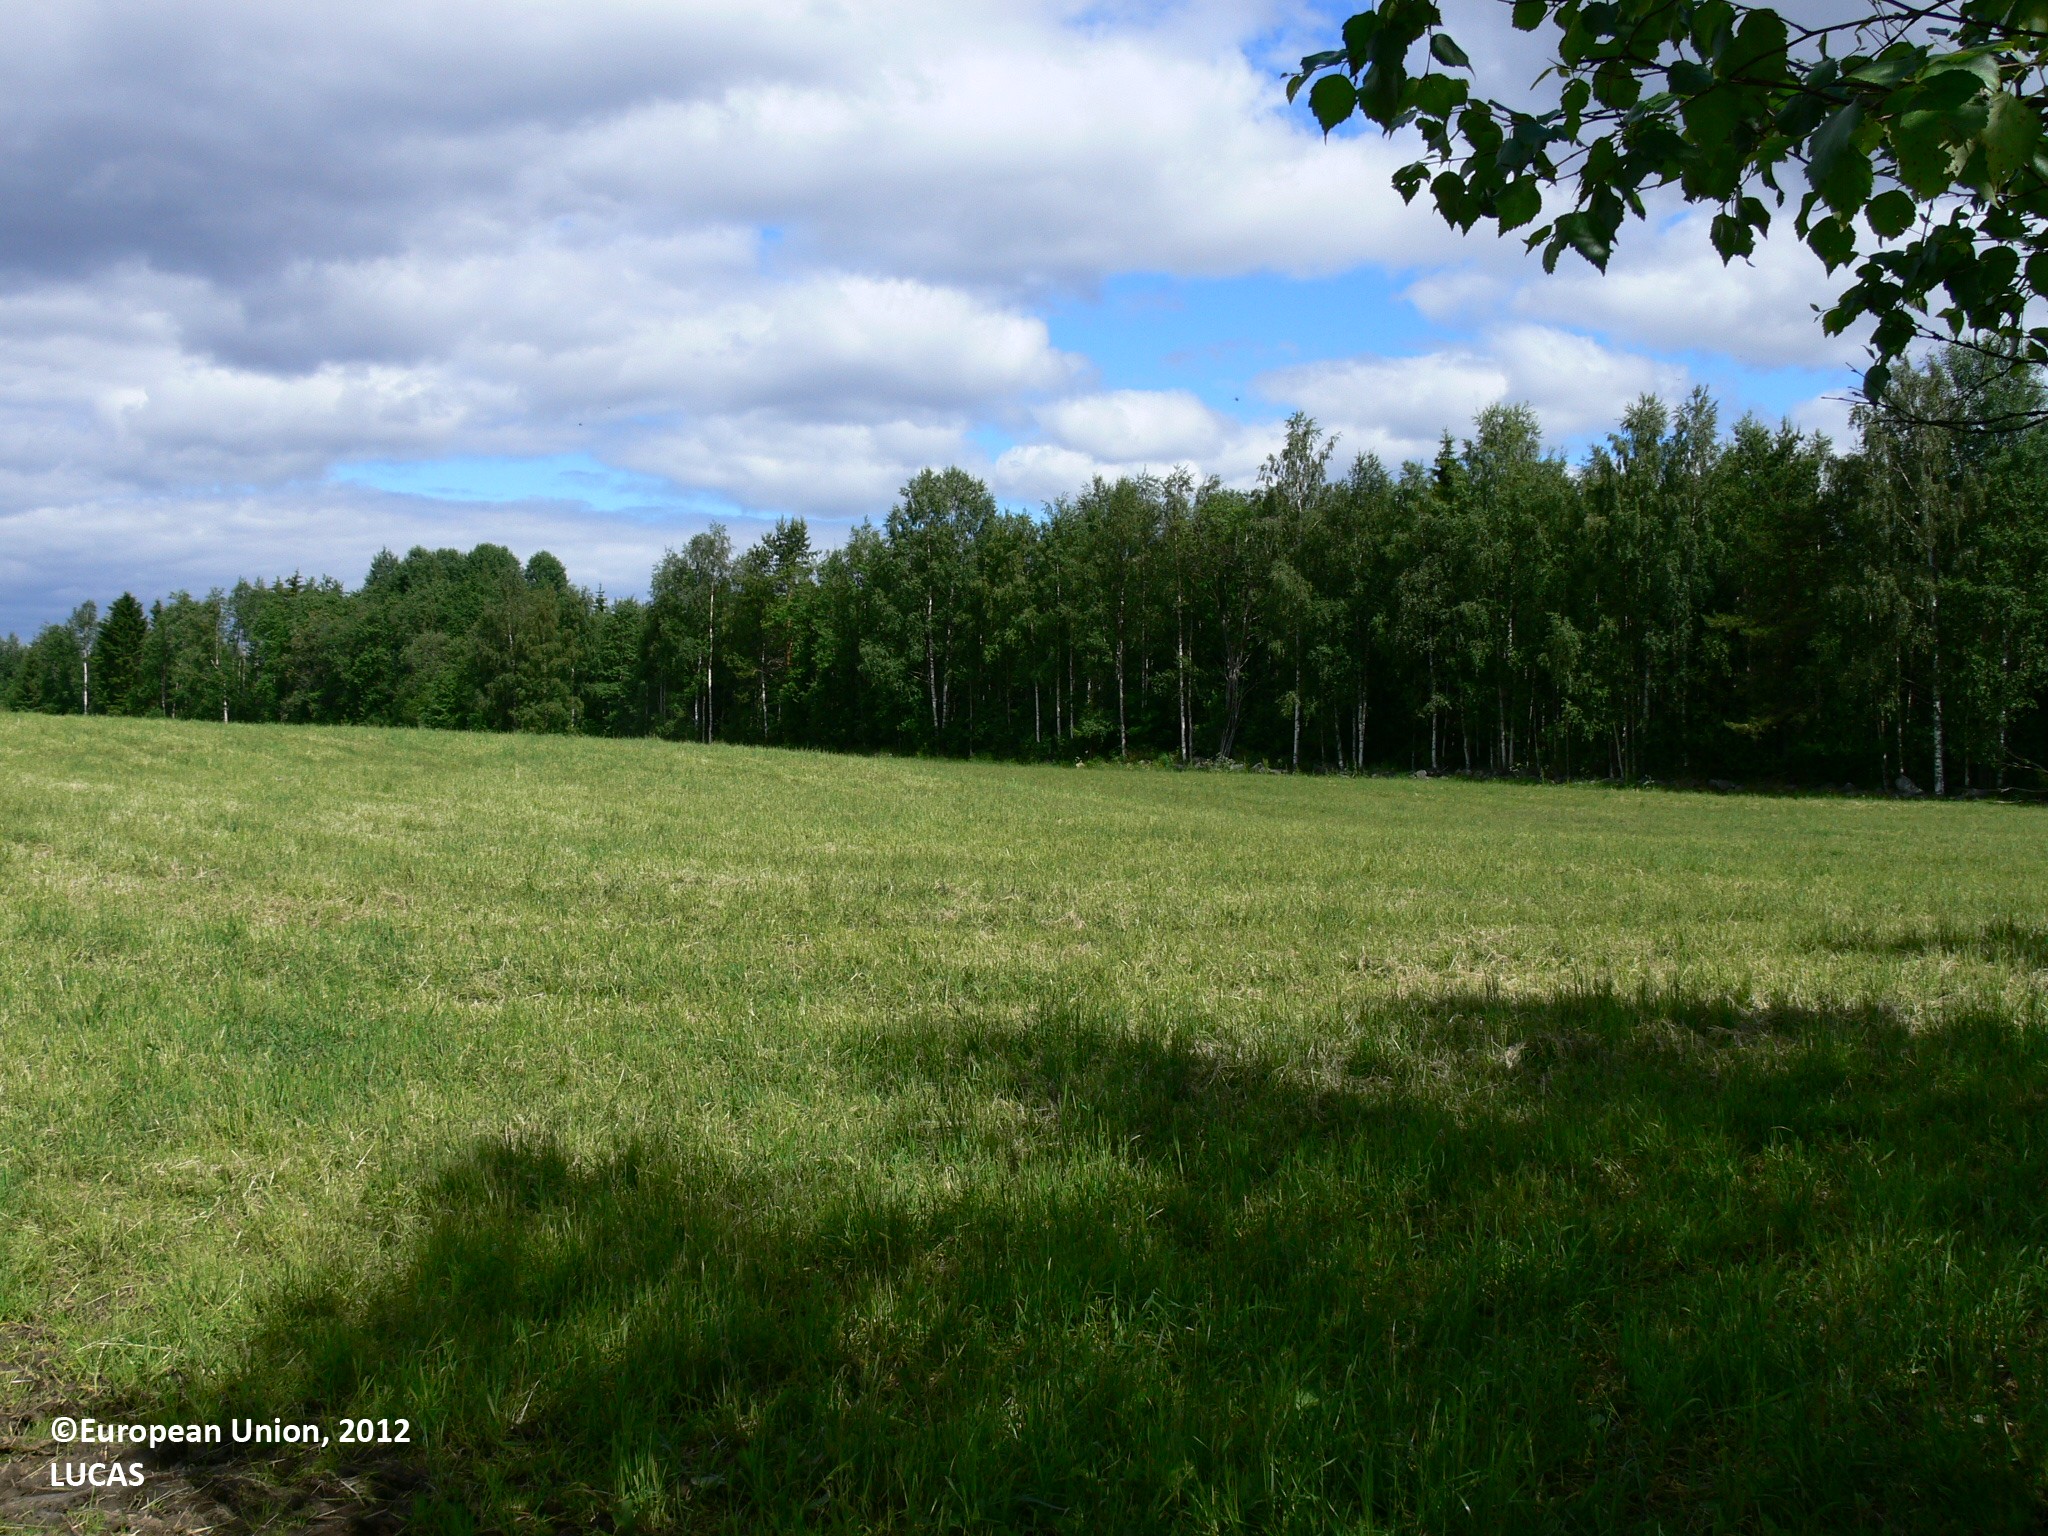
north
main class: Cropland
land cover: Temporary grasslands
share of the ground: 25 - 50 %
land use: Agriculture (excluding fallow land and kitchen gardens)
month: June
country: FI
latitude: 62.7197
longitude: 30.7268
